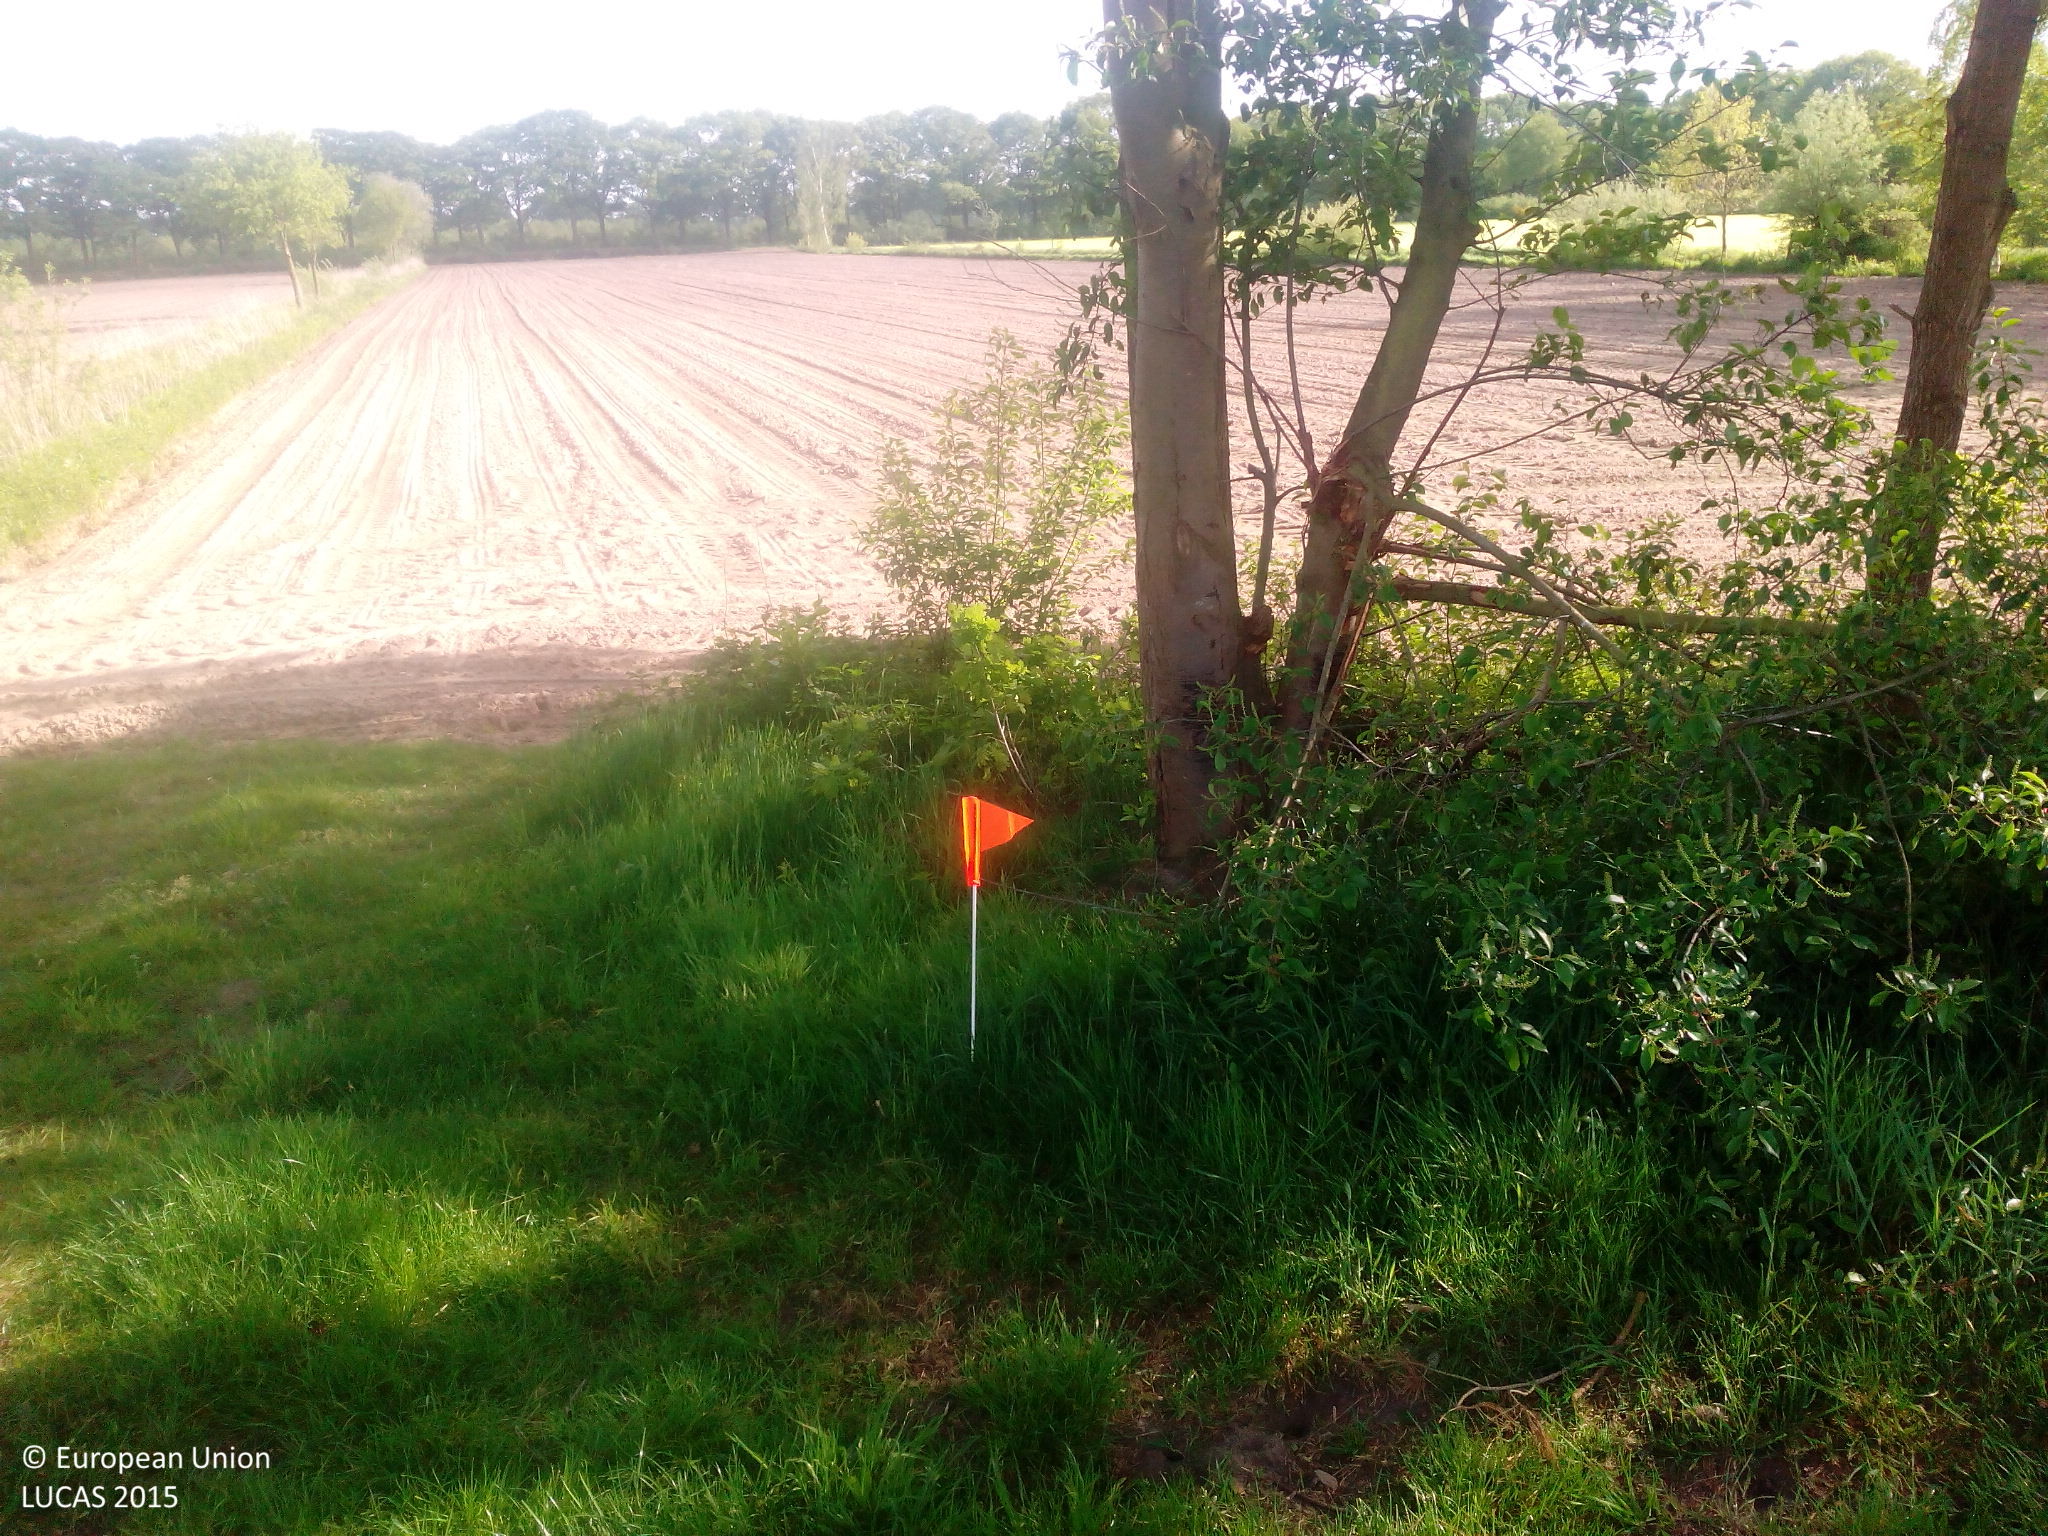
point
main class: Woodland
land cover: Pine dominated mixed woodland
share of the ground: 25 - 50 %
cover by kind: coniferous forest trees 35 %, unconsolidated bare surface 30 %, herbaceous plants 20 %, broadleaved forest trees 15 %
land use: Agriculture (excluding fallow land and kitchen gardens)
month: May
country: NL
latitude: 51.4671
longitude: 5.5790
